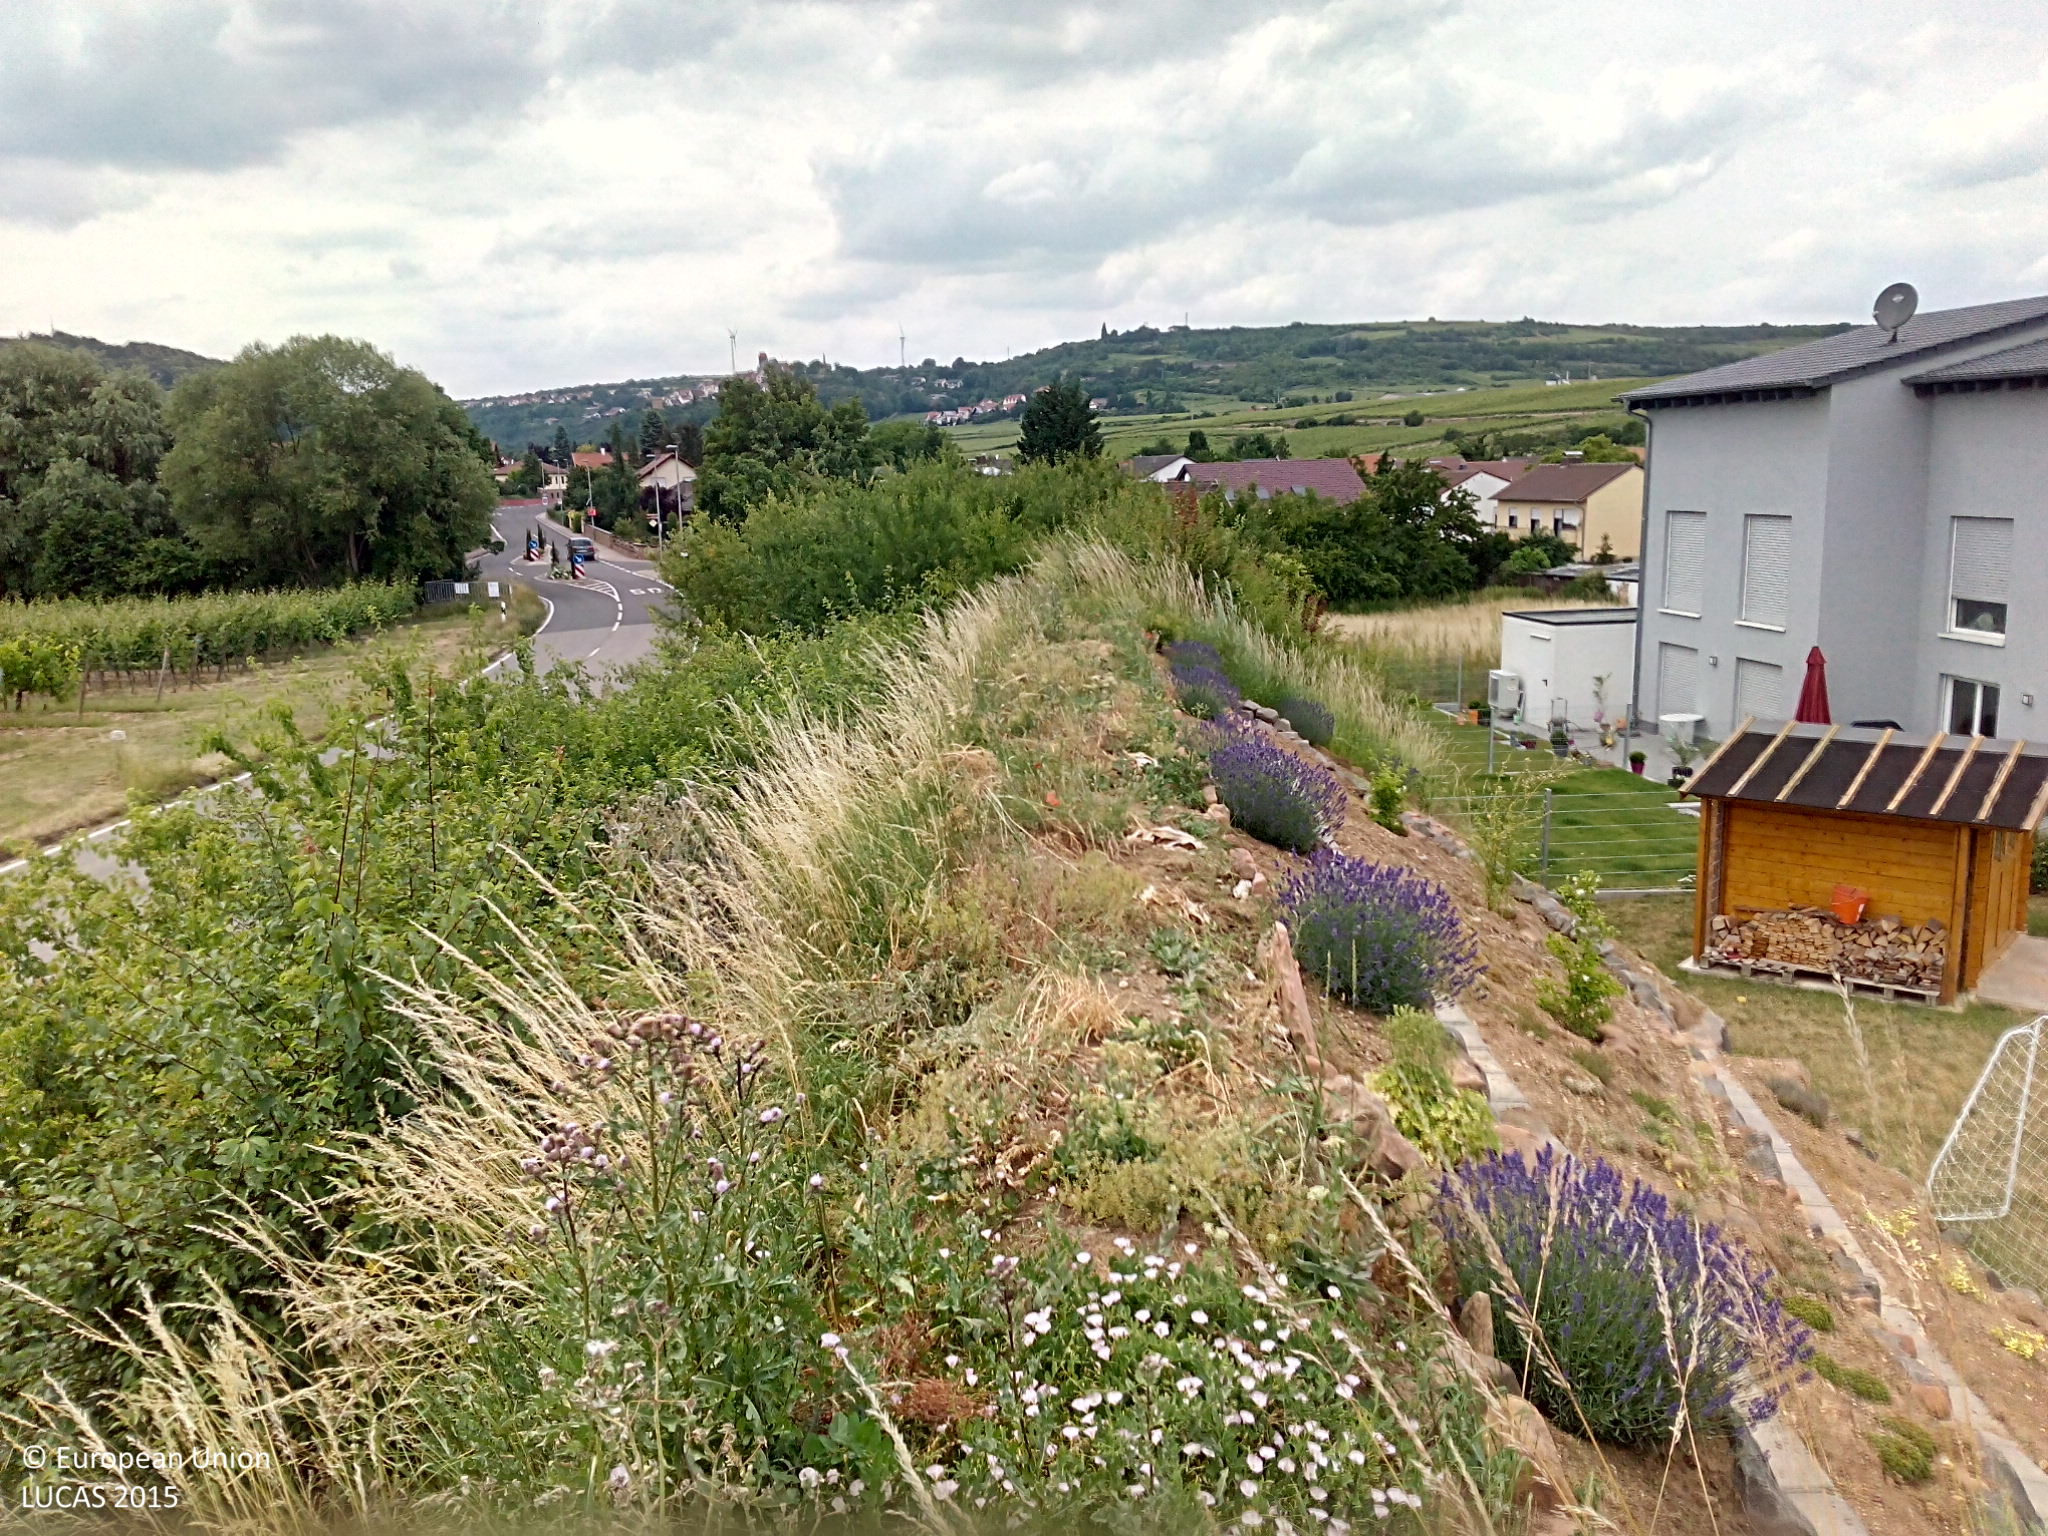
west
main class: Grassland
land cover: Grassland with sparse tree/shrub cover
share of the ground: > 75 %
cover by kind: herbaceous plants 65 %, unconsolidated bare surface 25 %, broadleaved forest trees 5 %, shrubs 5 %
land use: Residential
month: June
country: DE
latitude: 49.5399
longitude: 8.1625
